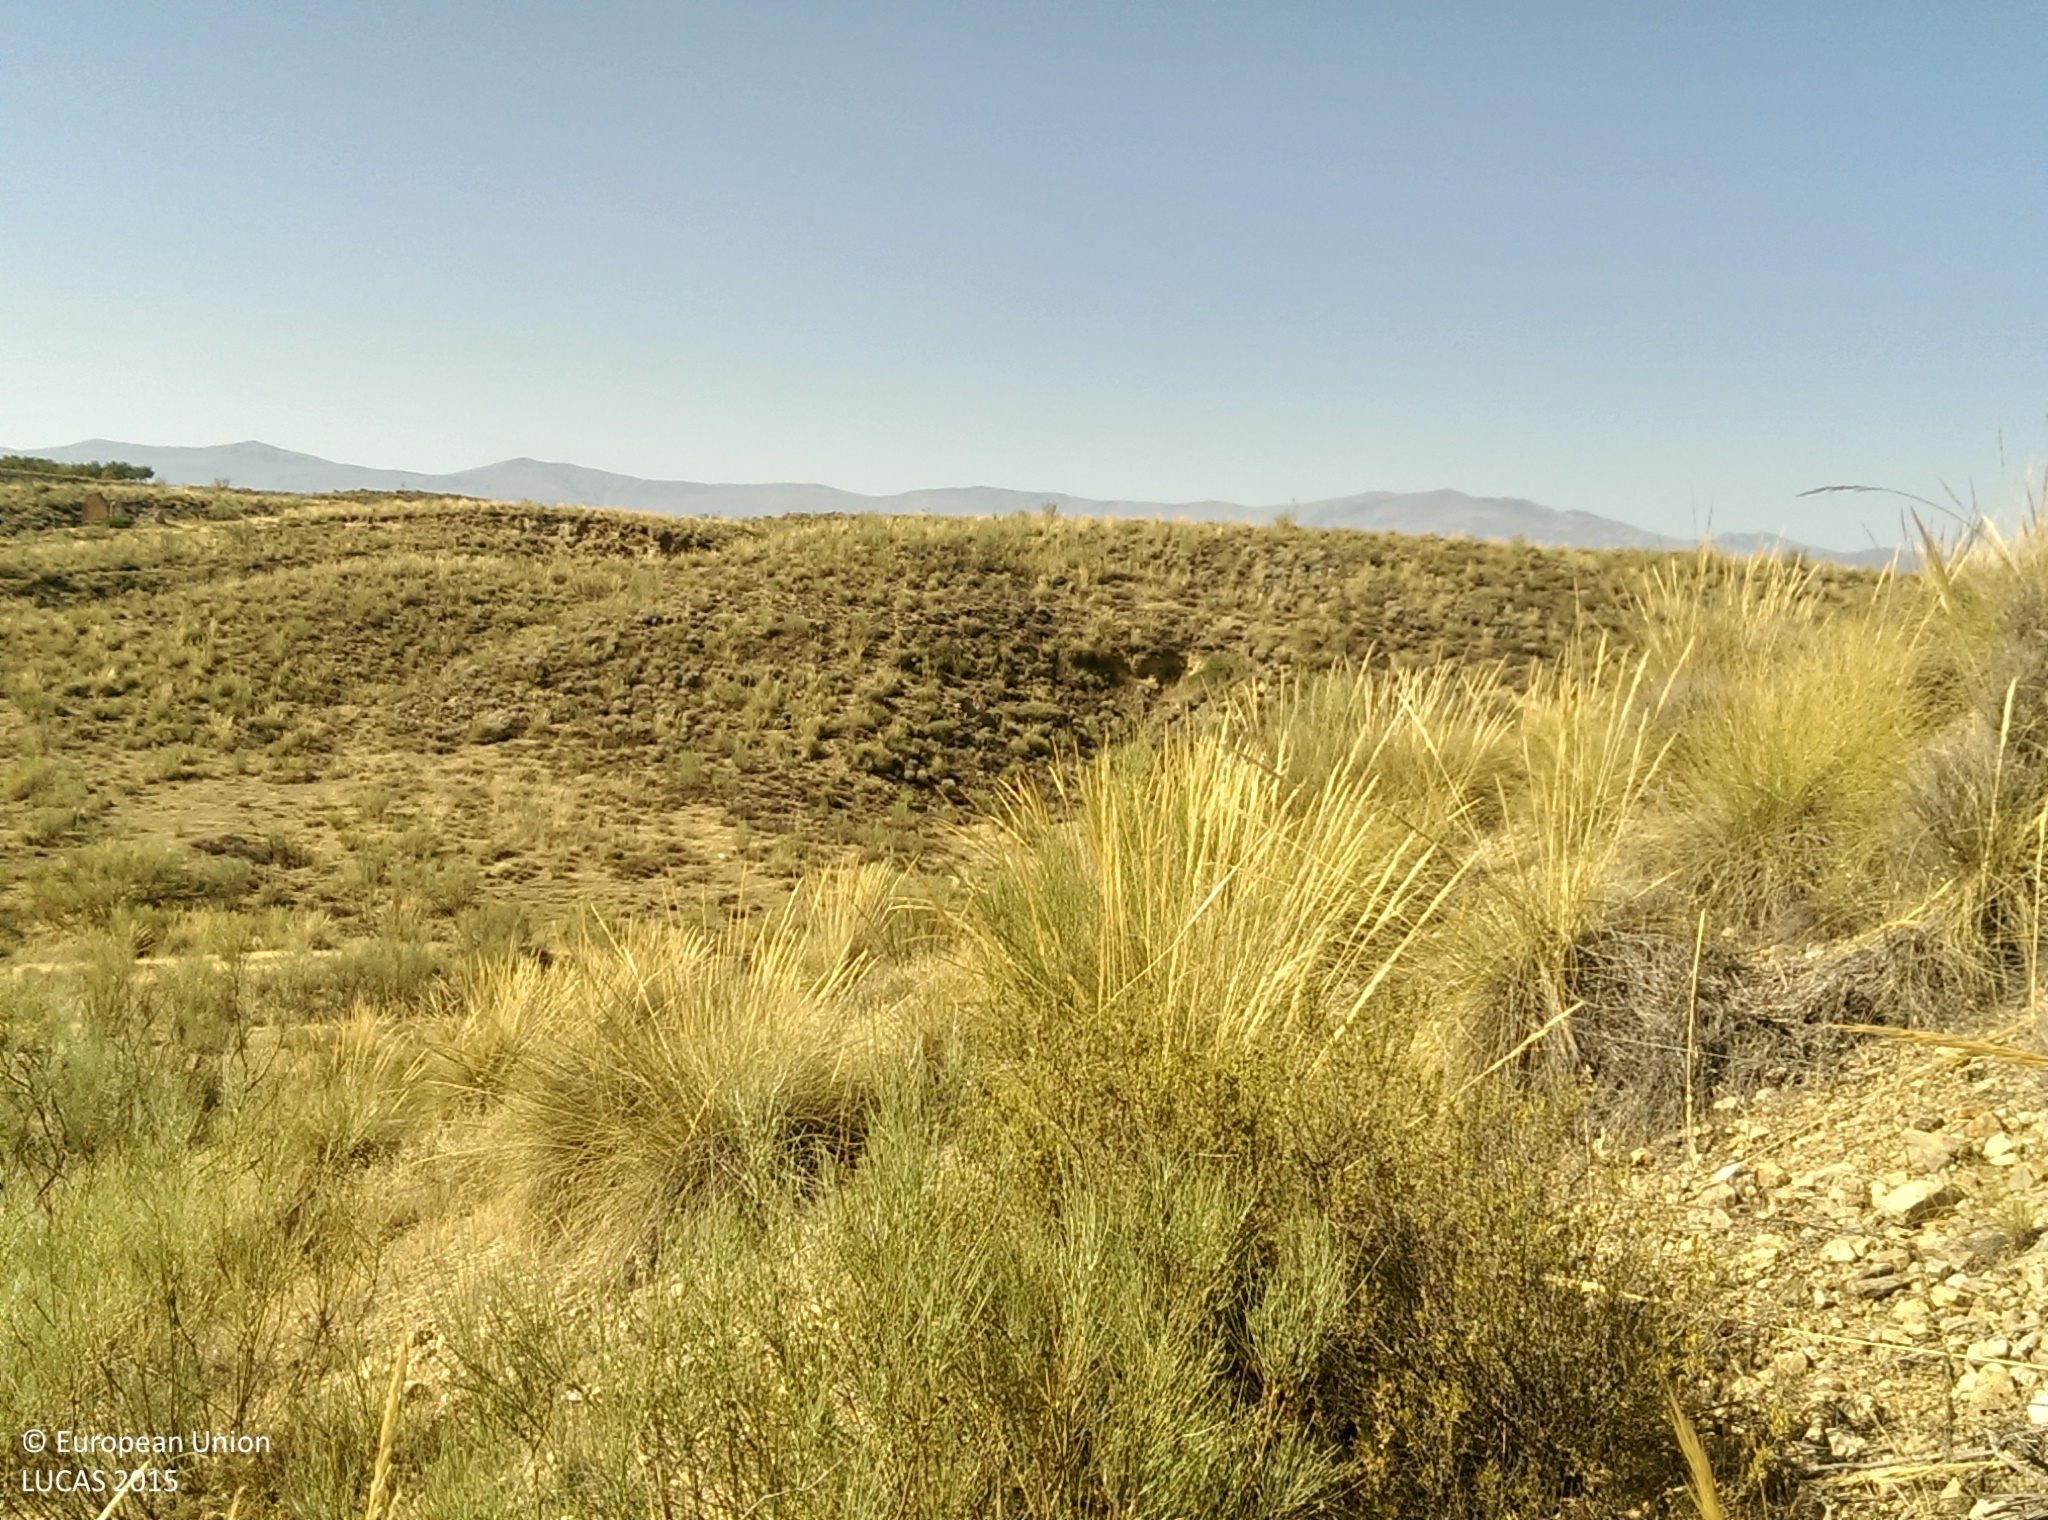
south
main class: Grassland
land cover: Grassland without tree/shrub cover
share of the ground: 50 - 75 %
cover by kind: herbaceous plants 70 %, unconsolidated bare surface 25 %, shrubs 5 %
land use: Semi-natural and natural areas not in use
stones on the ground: > 50 %
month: July
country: ES
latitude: 37.3485
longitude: -3.1165
